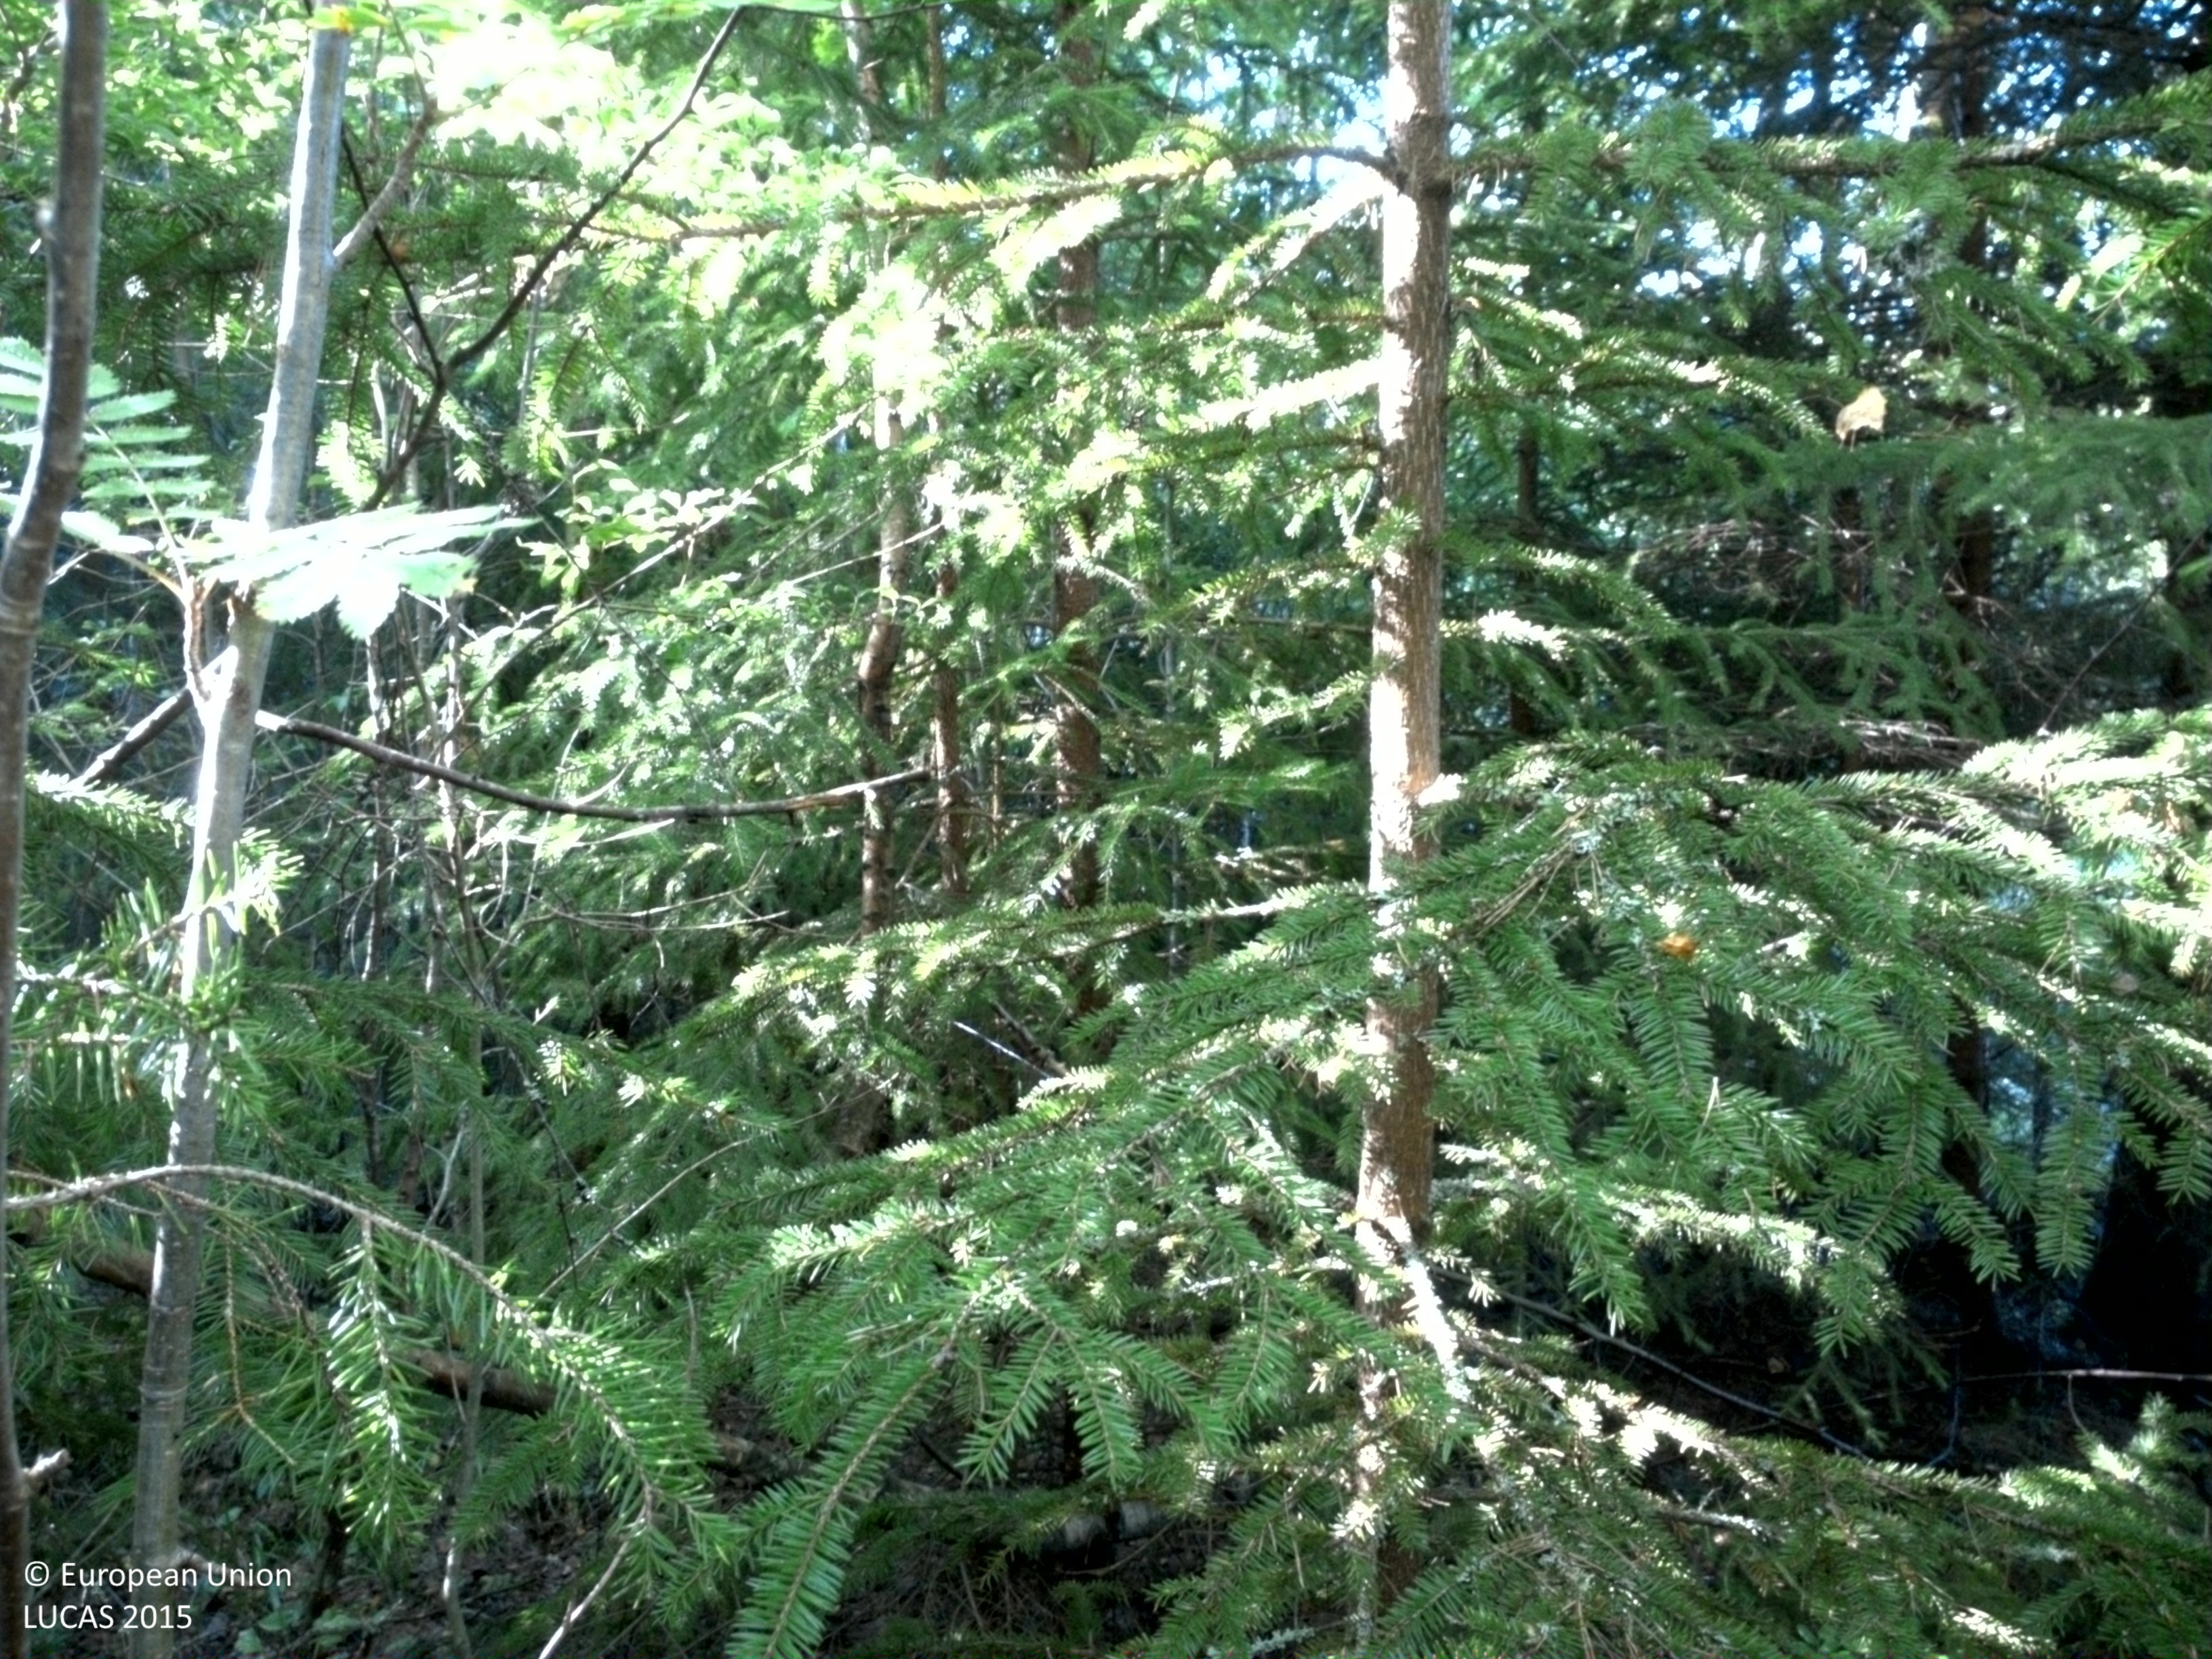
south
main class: Woodland
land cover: Spruce dominated mixed woodland
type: boreal forest
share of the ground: > 75 %
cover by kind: coniferous forest trees 50 %, broadleaved forest trees 35 %, shrubs 5 %, herbaceous plants 5 %, lichens and mosses 5 %
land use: Forestry
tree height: > 5 m
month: August
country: SE
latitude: 59.9950
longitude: 14.0954
